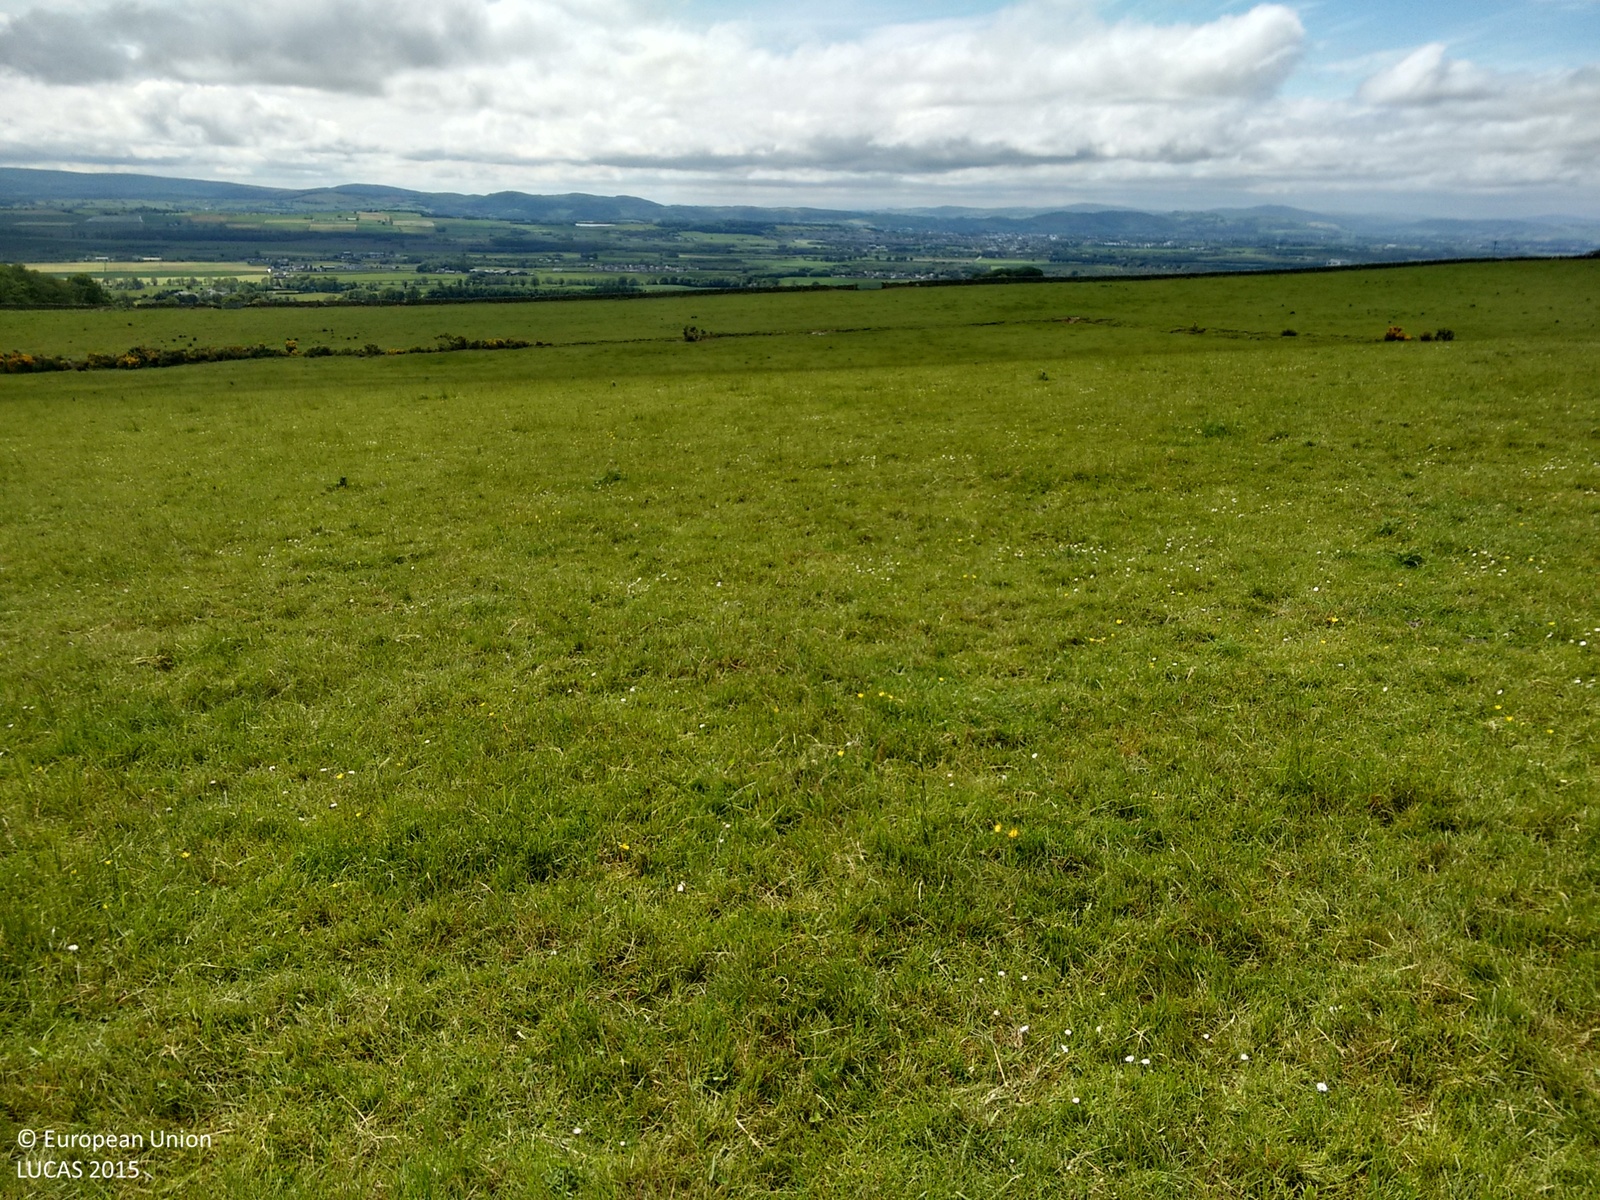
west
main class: Grassland
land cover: Grassland without tree/shrub cover
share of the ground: > 75 %
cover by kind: herbaceous plants 100 %
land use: Agriculture (excluding fallow land and kitchen gardens)
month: June
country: GB
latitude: 55.0716
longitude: -3.4699
